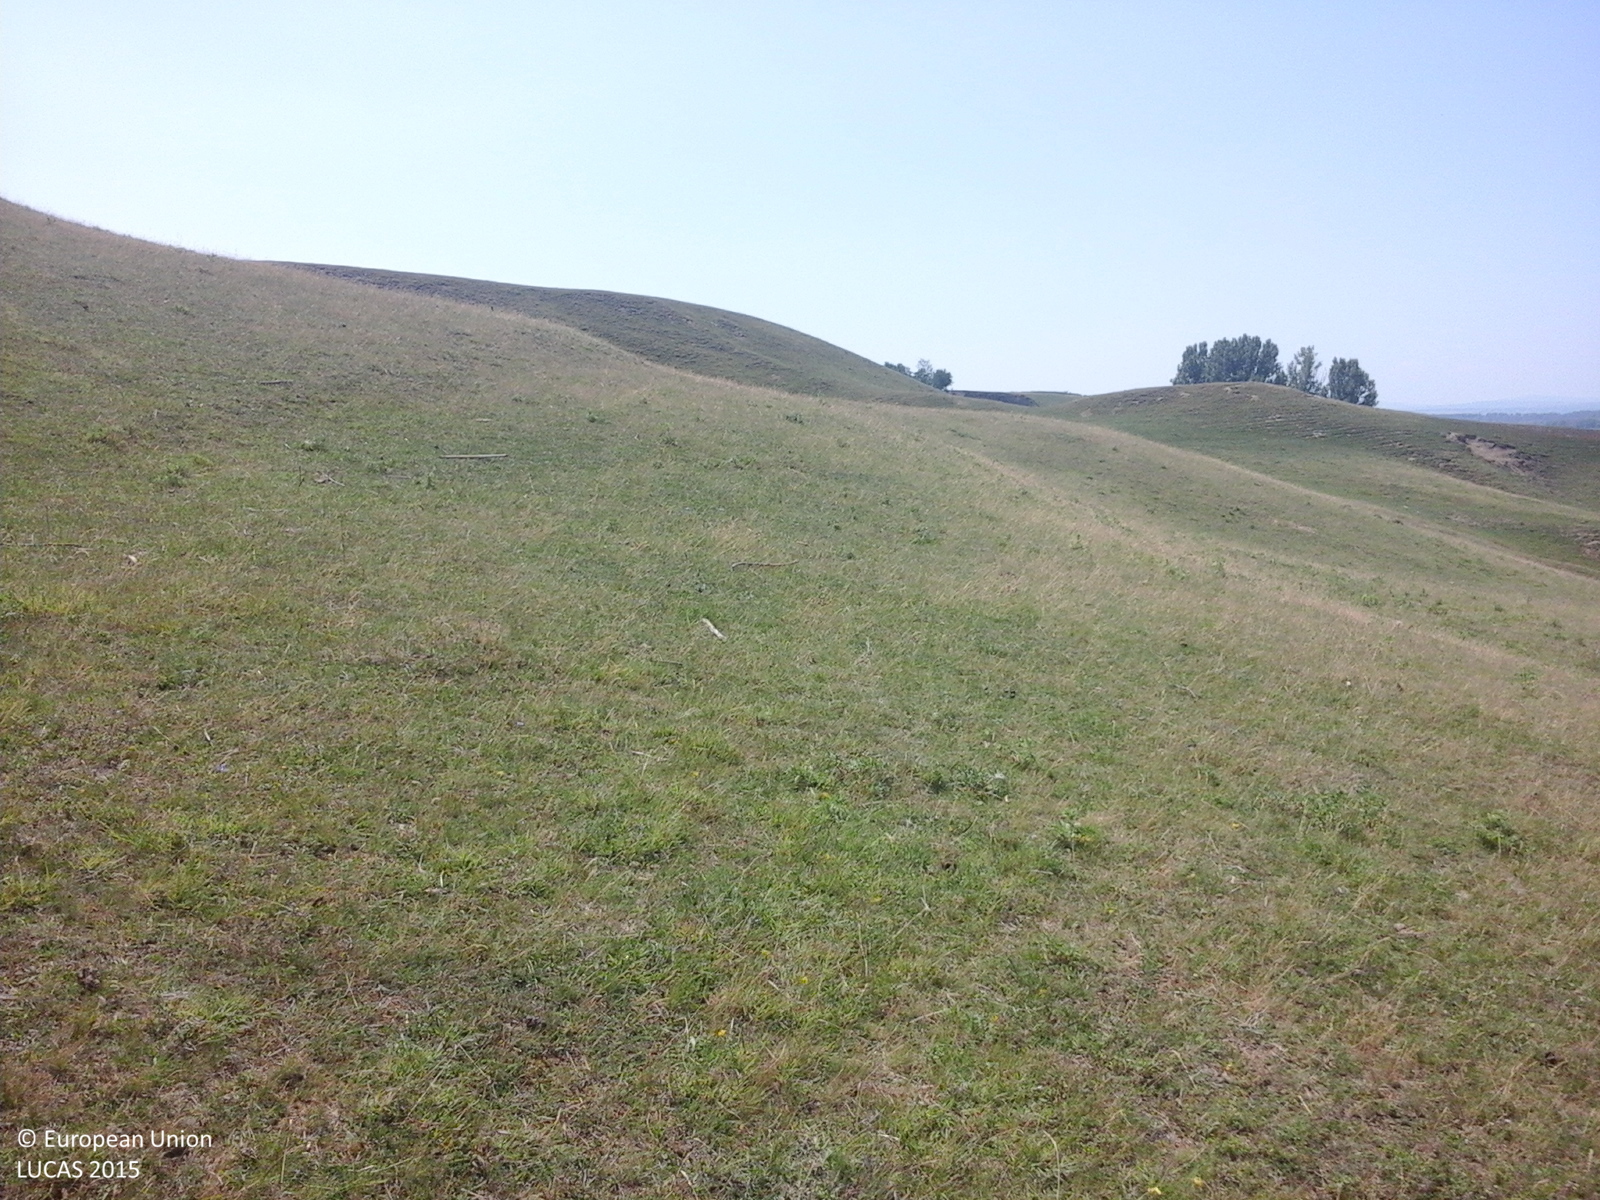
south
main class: Grassland
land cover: Grassland without tree/shrub cover
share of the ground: > 75 %
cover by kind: herbaceous plants 100 %
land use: Agriculture (excluding fallow land and kitchen gardens)
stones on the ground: < 10 %
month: June
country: RO
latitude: 46.8259
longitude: 26.9413
